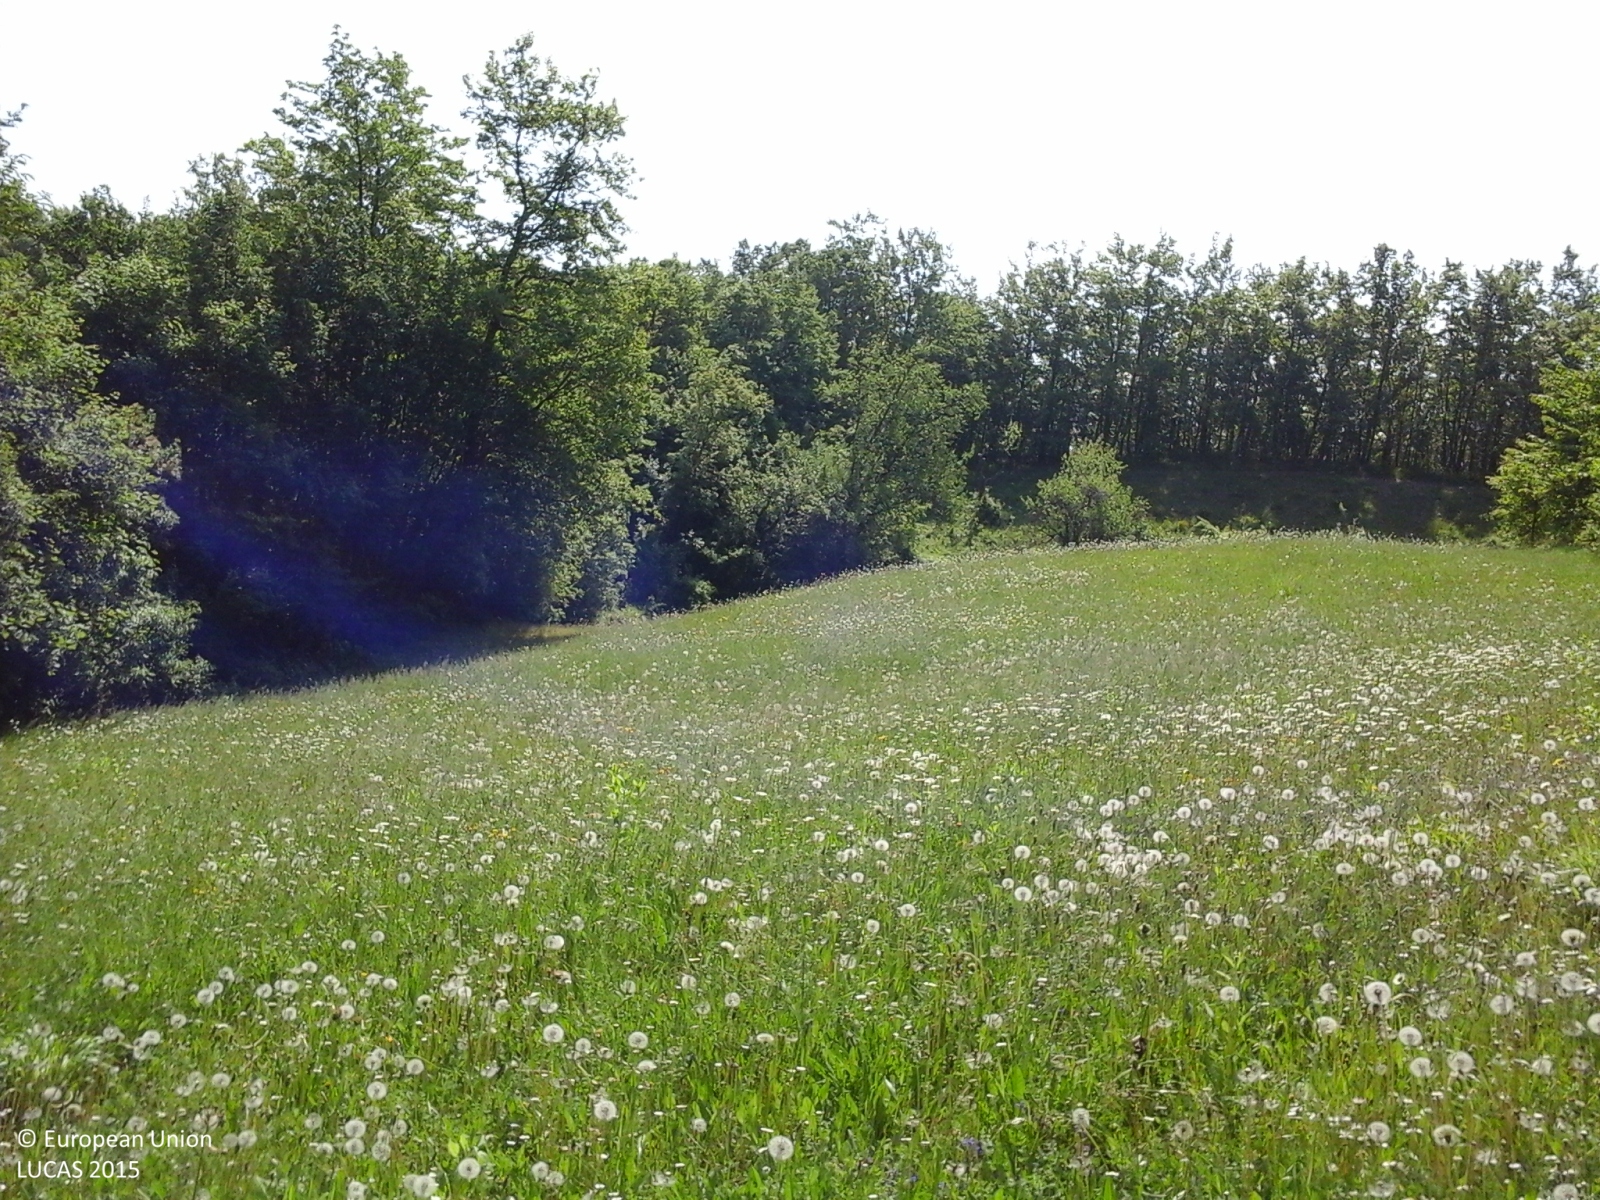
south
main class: Grassland
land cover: Grassland without tree/shrub cover
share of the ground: > 75 %
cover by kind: herbaceous plants 100 %
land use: Agriculture (excluding fallow land and kitchen gardens)
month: May
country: IT
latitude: 44.8177
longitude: 9.4069
